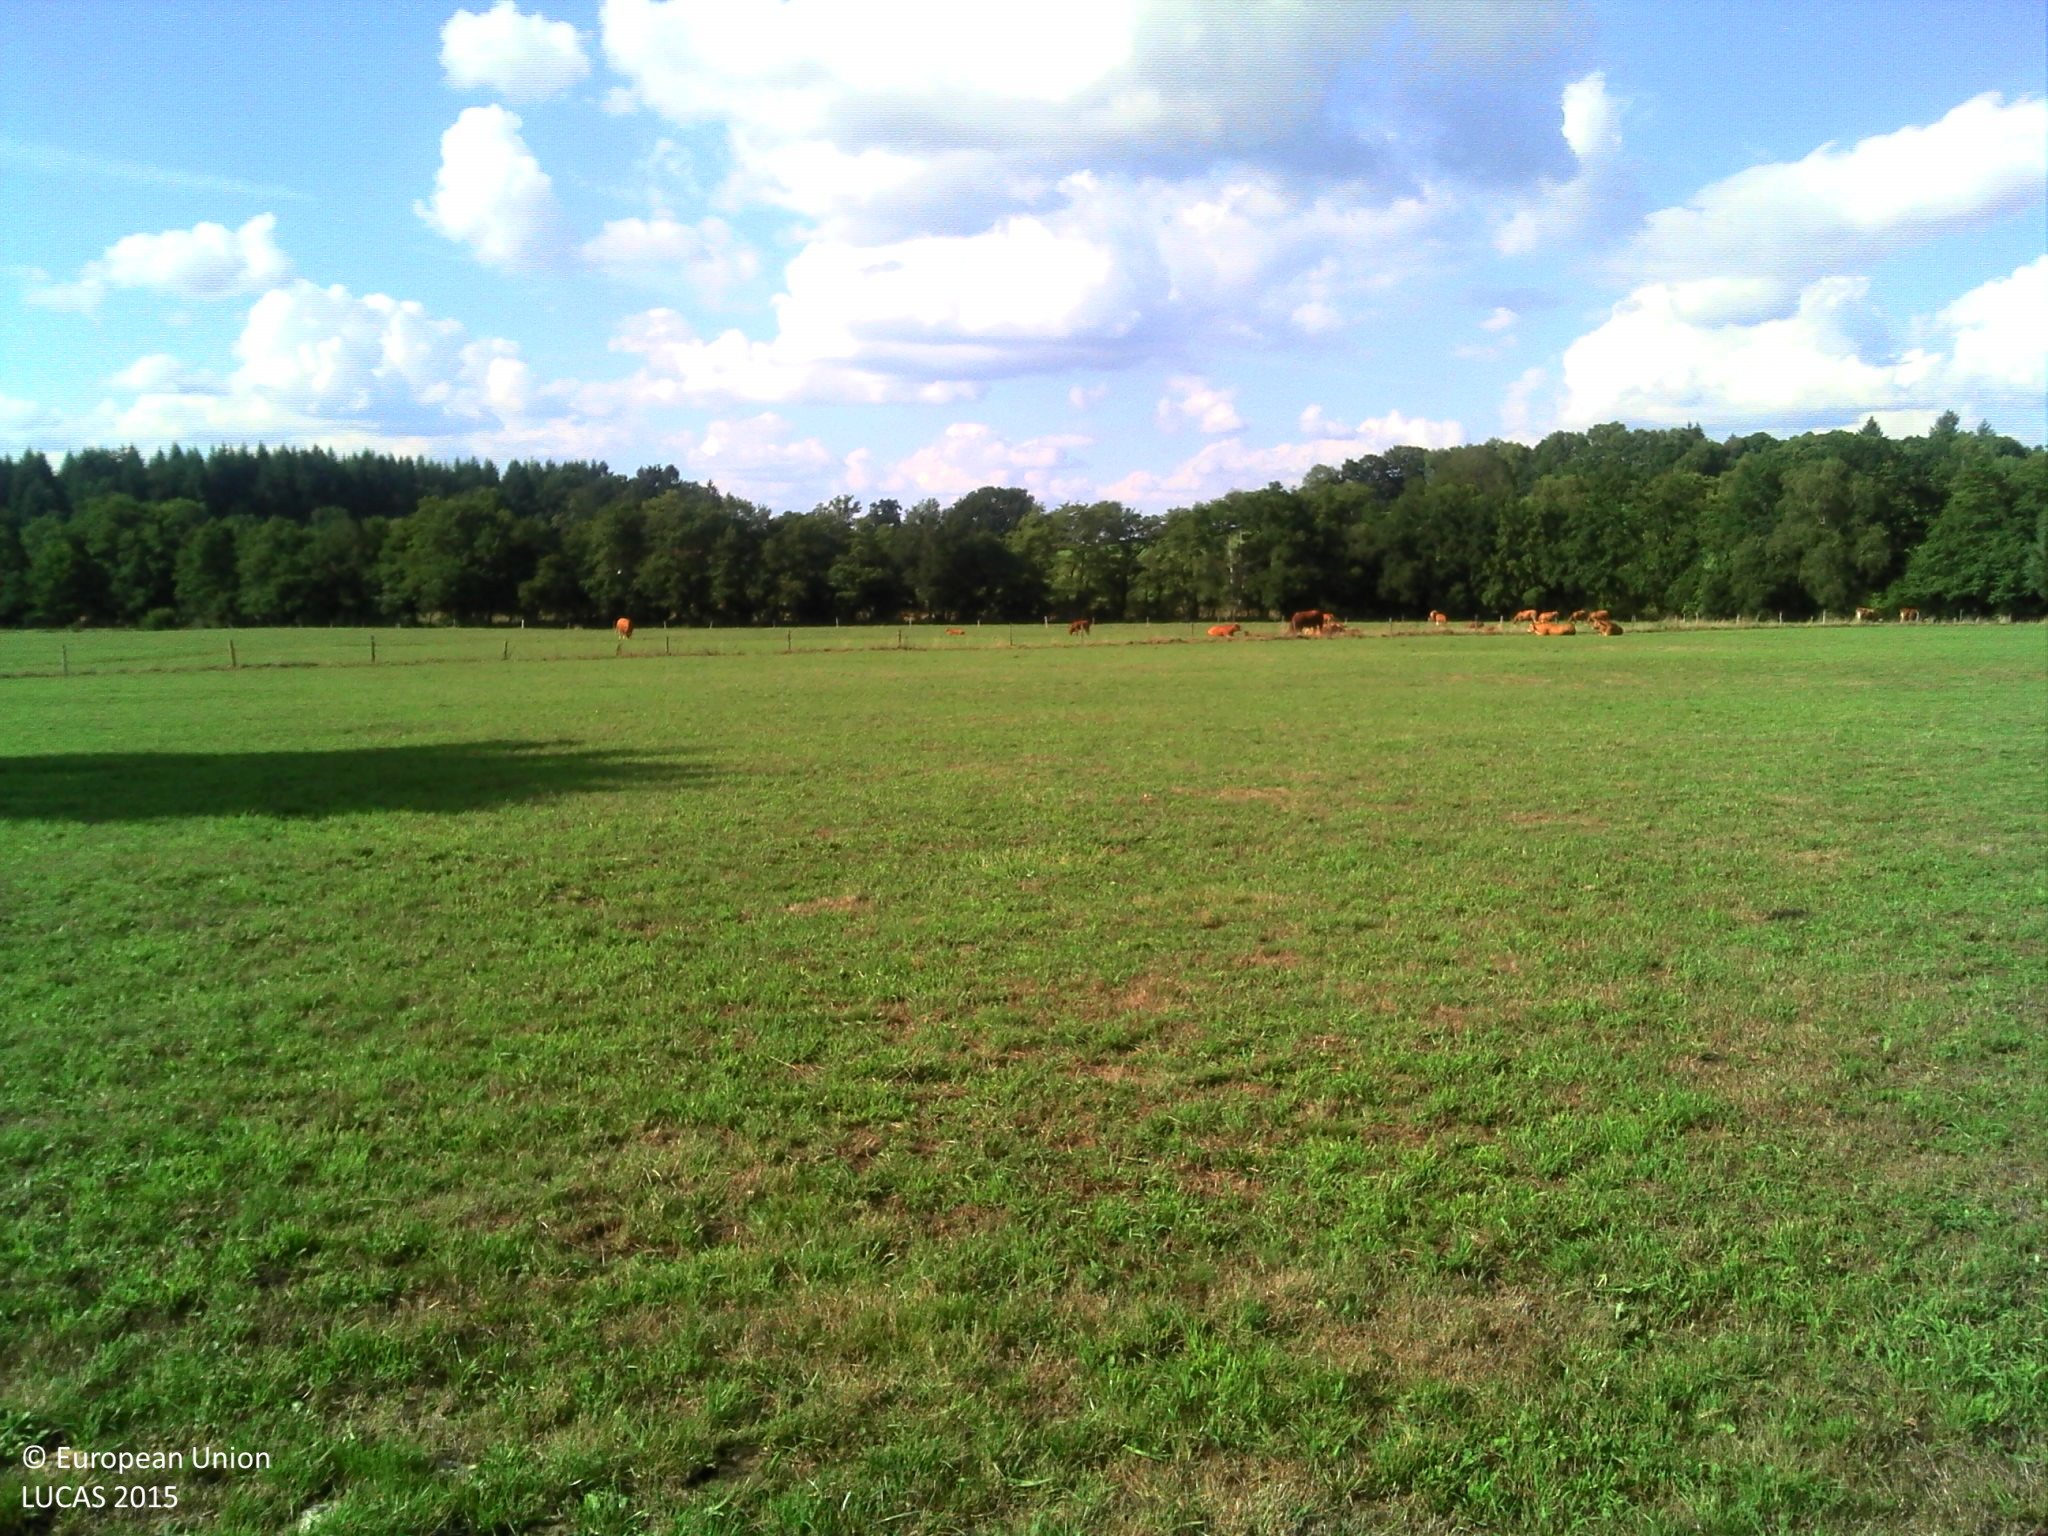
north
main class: Grassland
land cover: Grassland without tree/shrub cover
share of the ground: > 75 %
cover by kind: herbaceous plants 100 %
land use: Agriculture (excluding fallow land and kitchen gardens)
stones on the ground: < 10 %
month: August
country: FR
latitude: 45.9377
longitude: 1.6996
